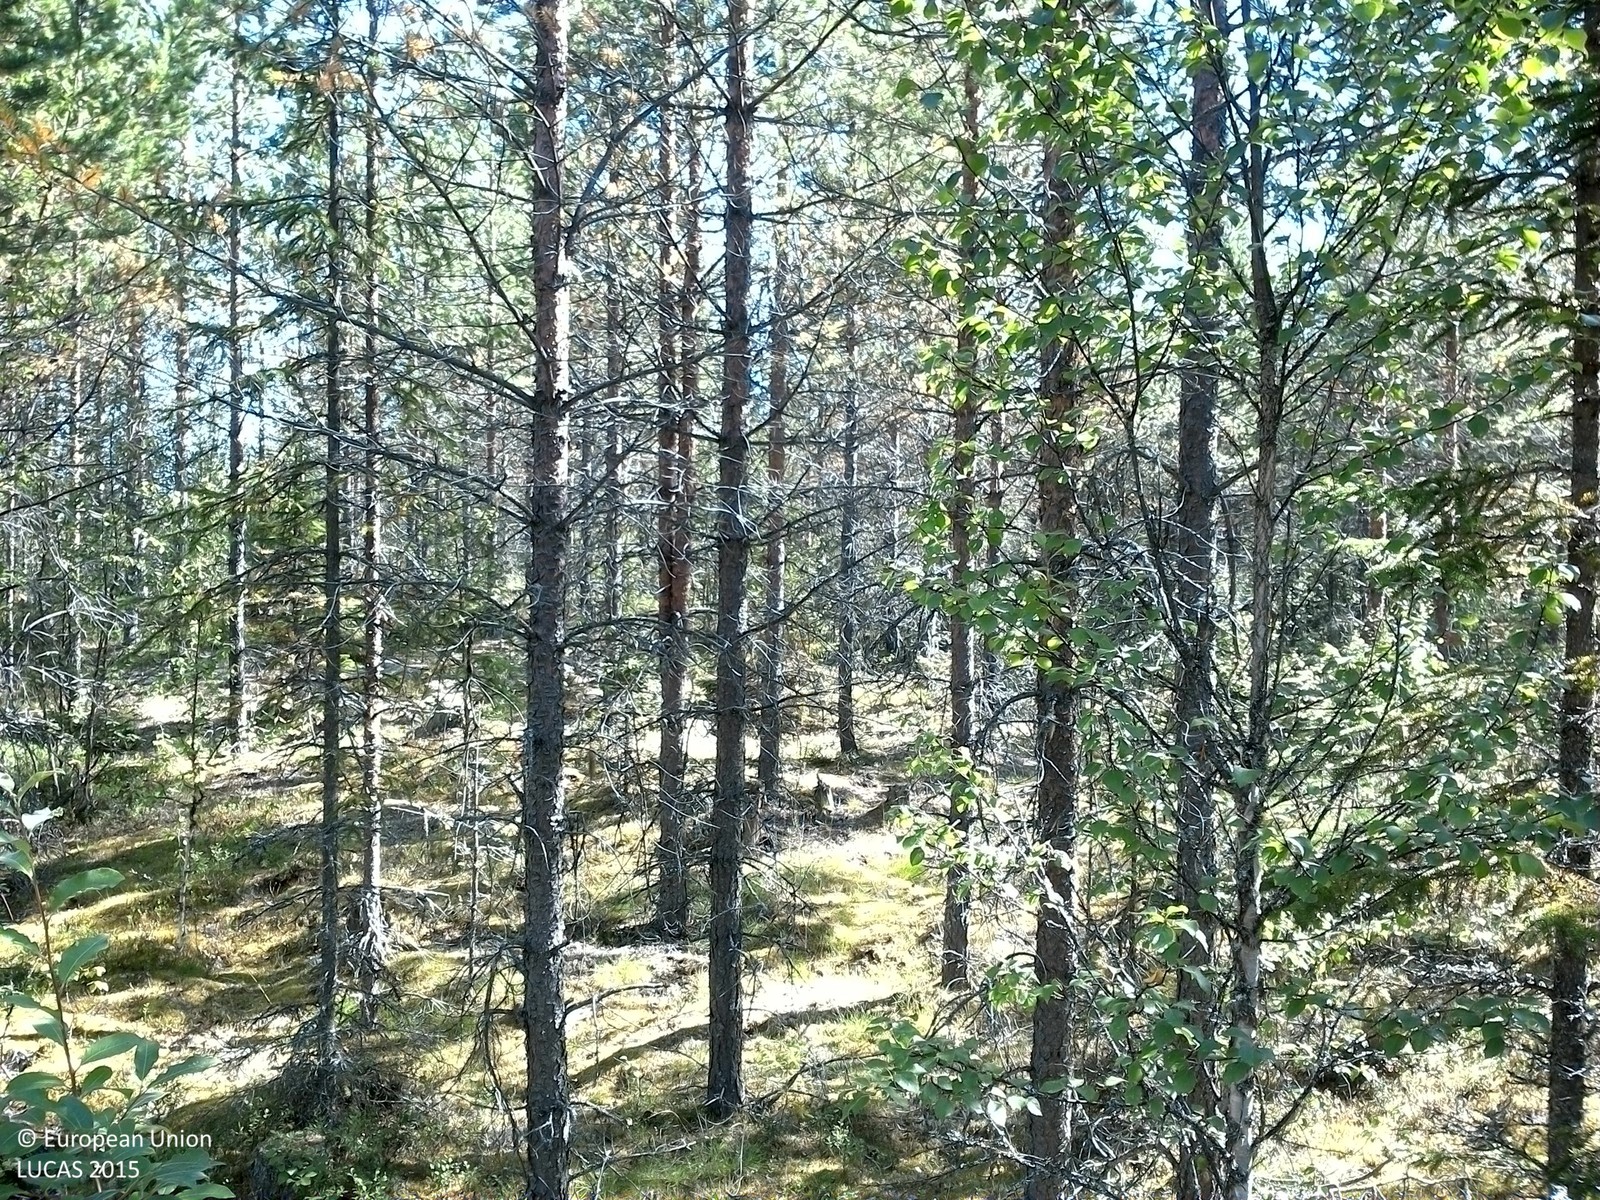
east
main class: Woodland
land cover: Pine dominated coniferous woodland
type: boreal forest
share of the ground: > 75 %
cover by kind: coniferous forest trees 75 %, shrubs 15 %, herbaceous plants 5 %, lichens and mosses 5 %
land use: Forestry
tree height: < 5 m
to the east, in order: Pine dominated coniferous woodland; Pine dominated mixed woodland; Pine dominated coniferous woodland; Pine dominated mixed woodland
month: August
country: SE
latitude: 63.7249
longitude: 17.2411
